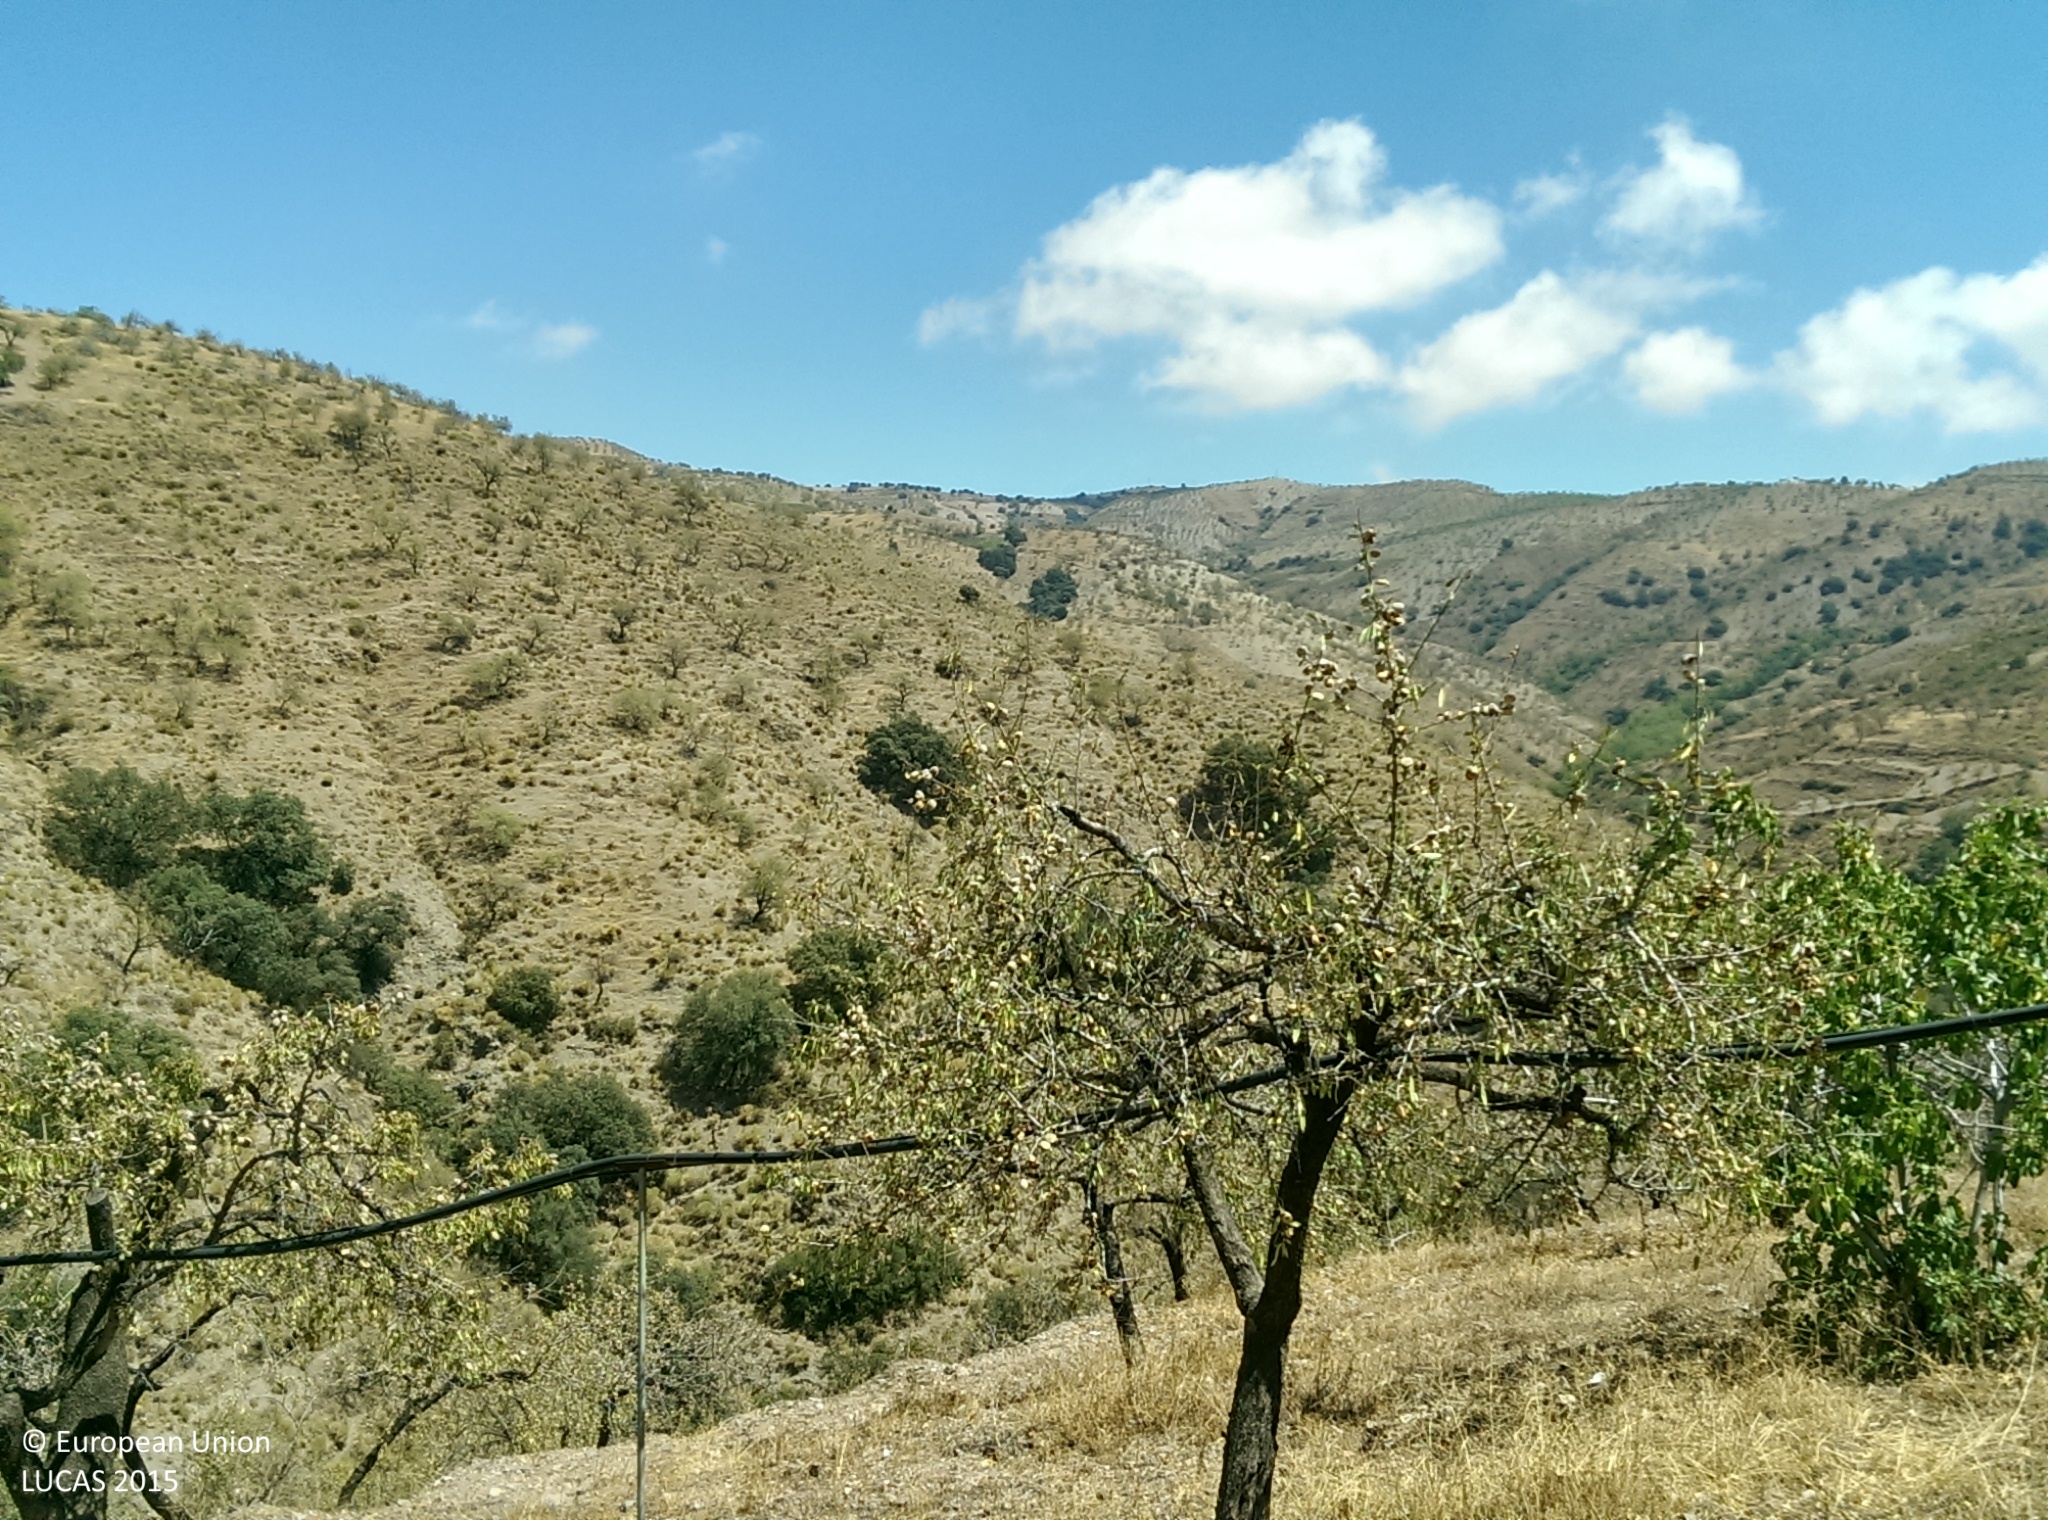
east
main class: Cropland
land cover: Nuts trees
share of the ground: 25 - 50 %
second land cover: Other bare soil
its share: > 75 %
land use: Agriculture (excluding fallow land and kitchen gardens)
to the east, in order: Nuts trees; Other bare soil; Broadleaved woodland; Rivers and streams; Broadleaved woodland; Nuts trees; Broadleaved woodland
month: August
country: ES
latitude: 36.8621
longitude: -3.1827
